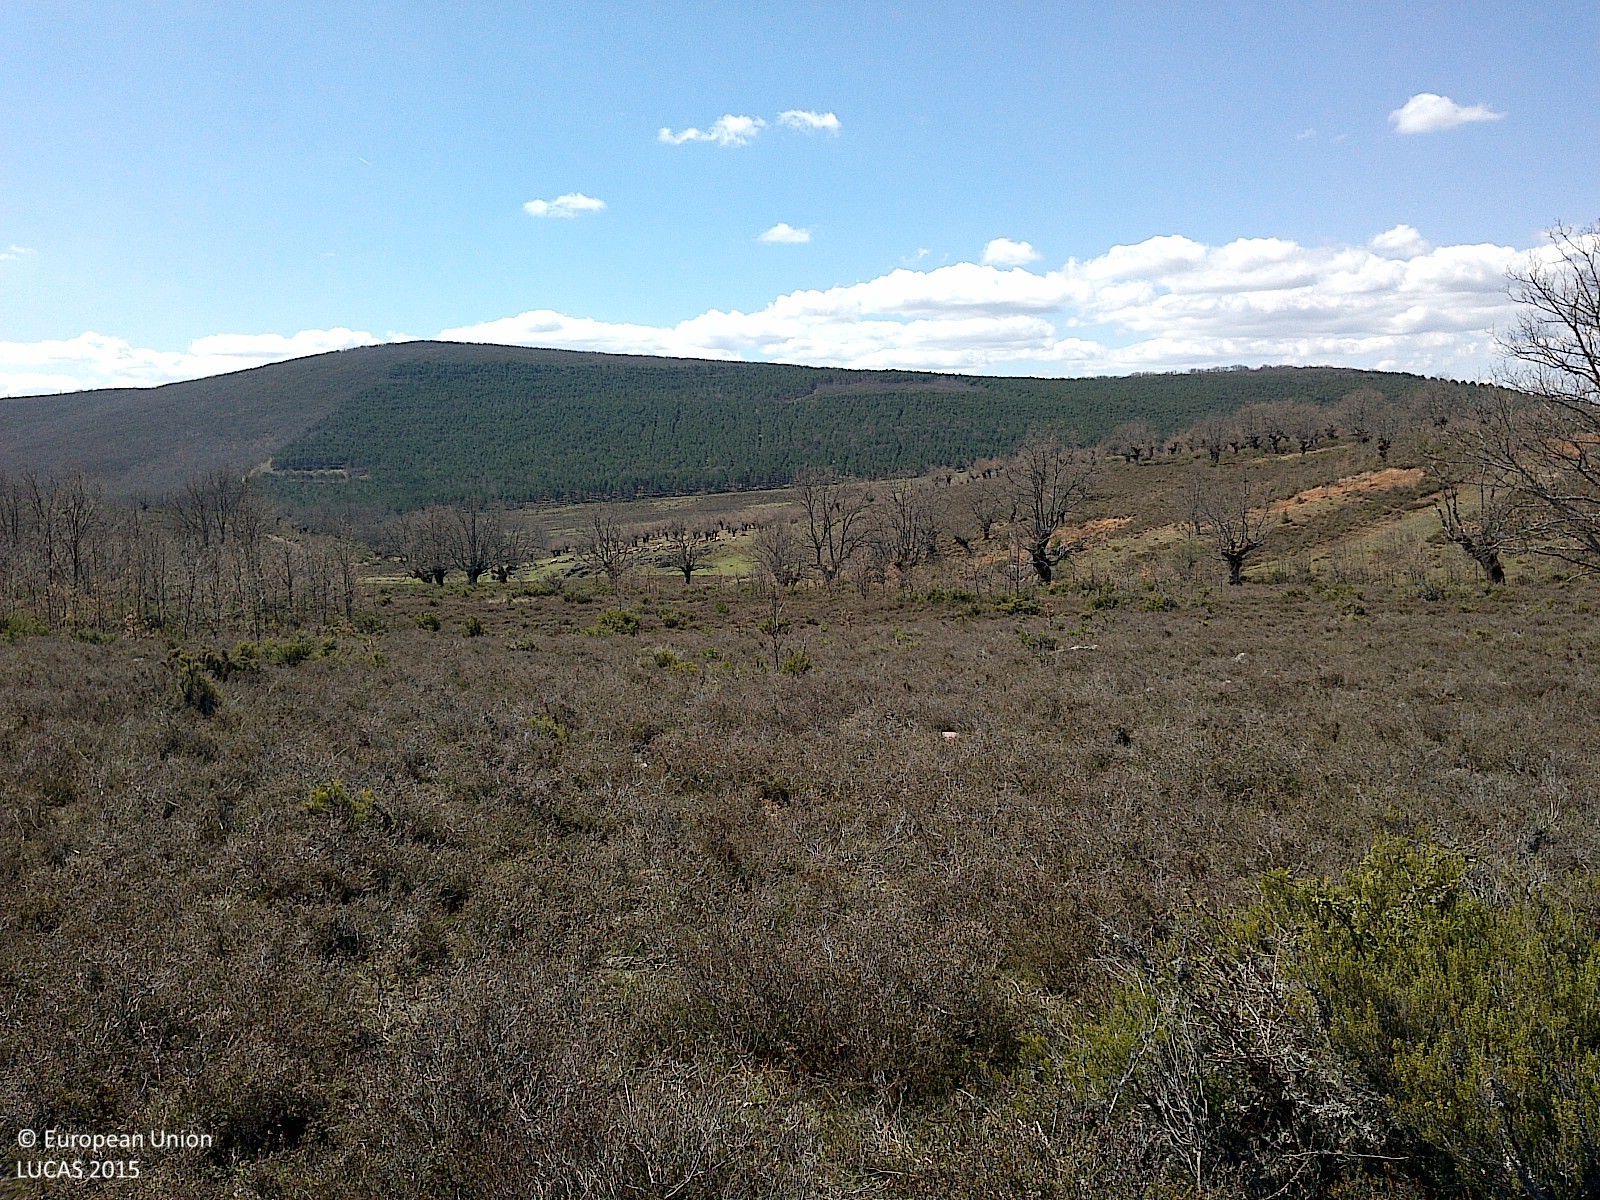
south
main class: Shrubland
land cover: Shrubland without tree cover
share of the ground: > 75 %
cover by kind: shrubs 95 %, herbaceous plants 5 %
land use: Agriculture (excluding fallow land and kitchen gardens)
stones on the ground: < 10 %
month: April
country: ES
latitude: 42.1558
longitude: -3.3048
